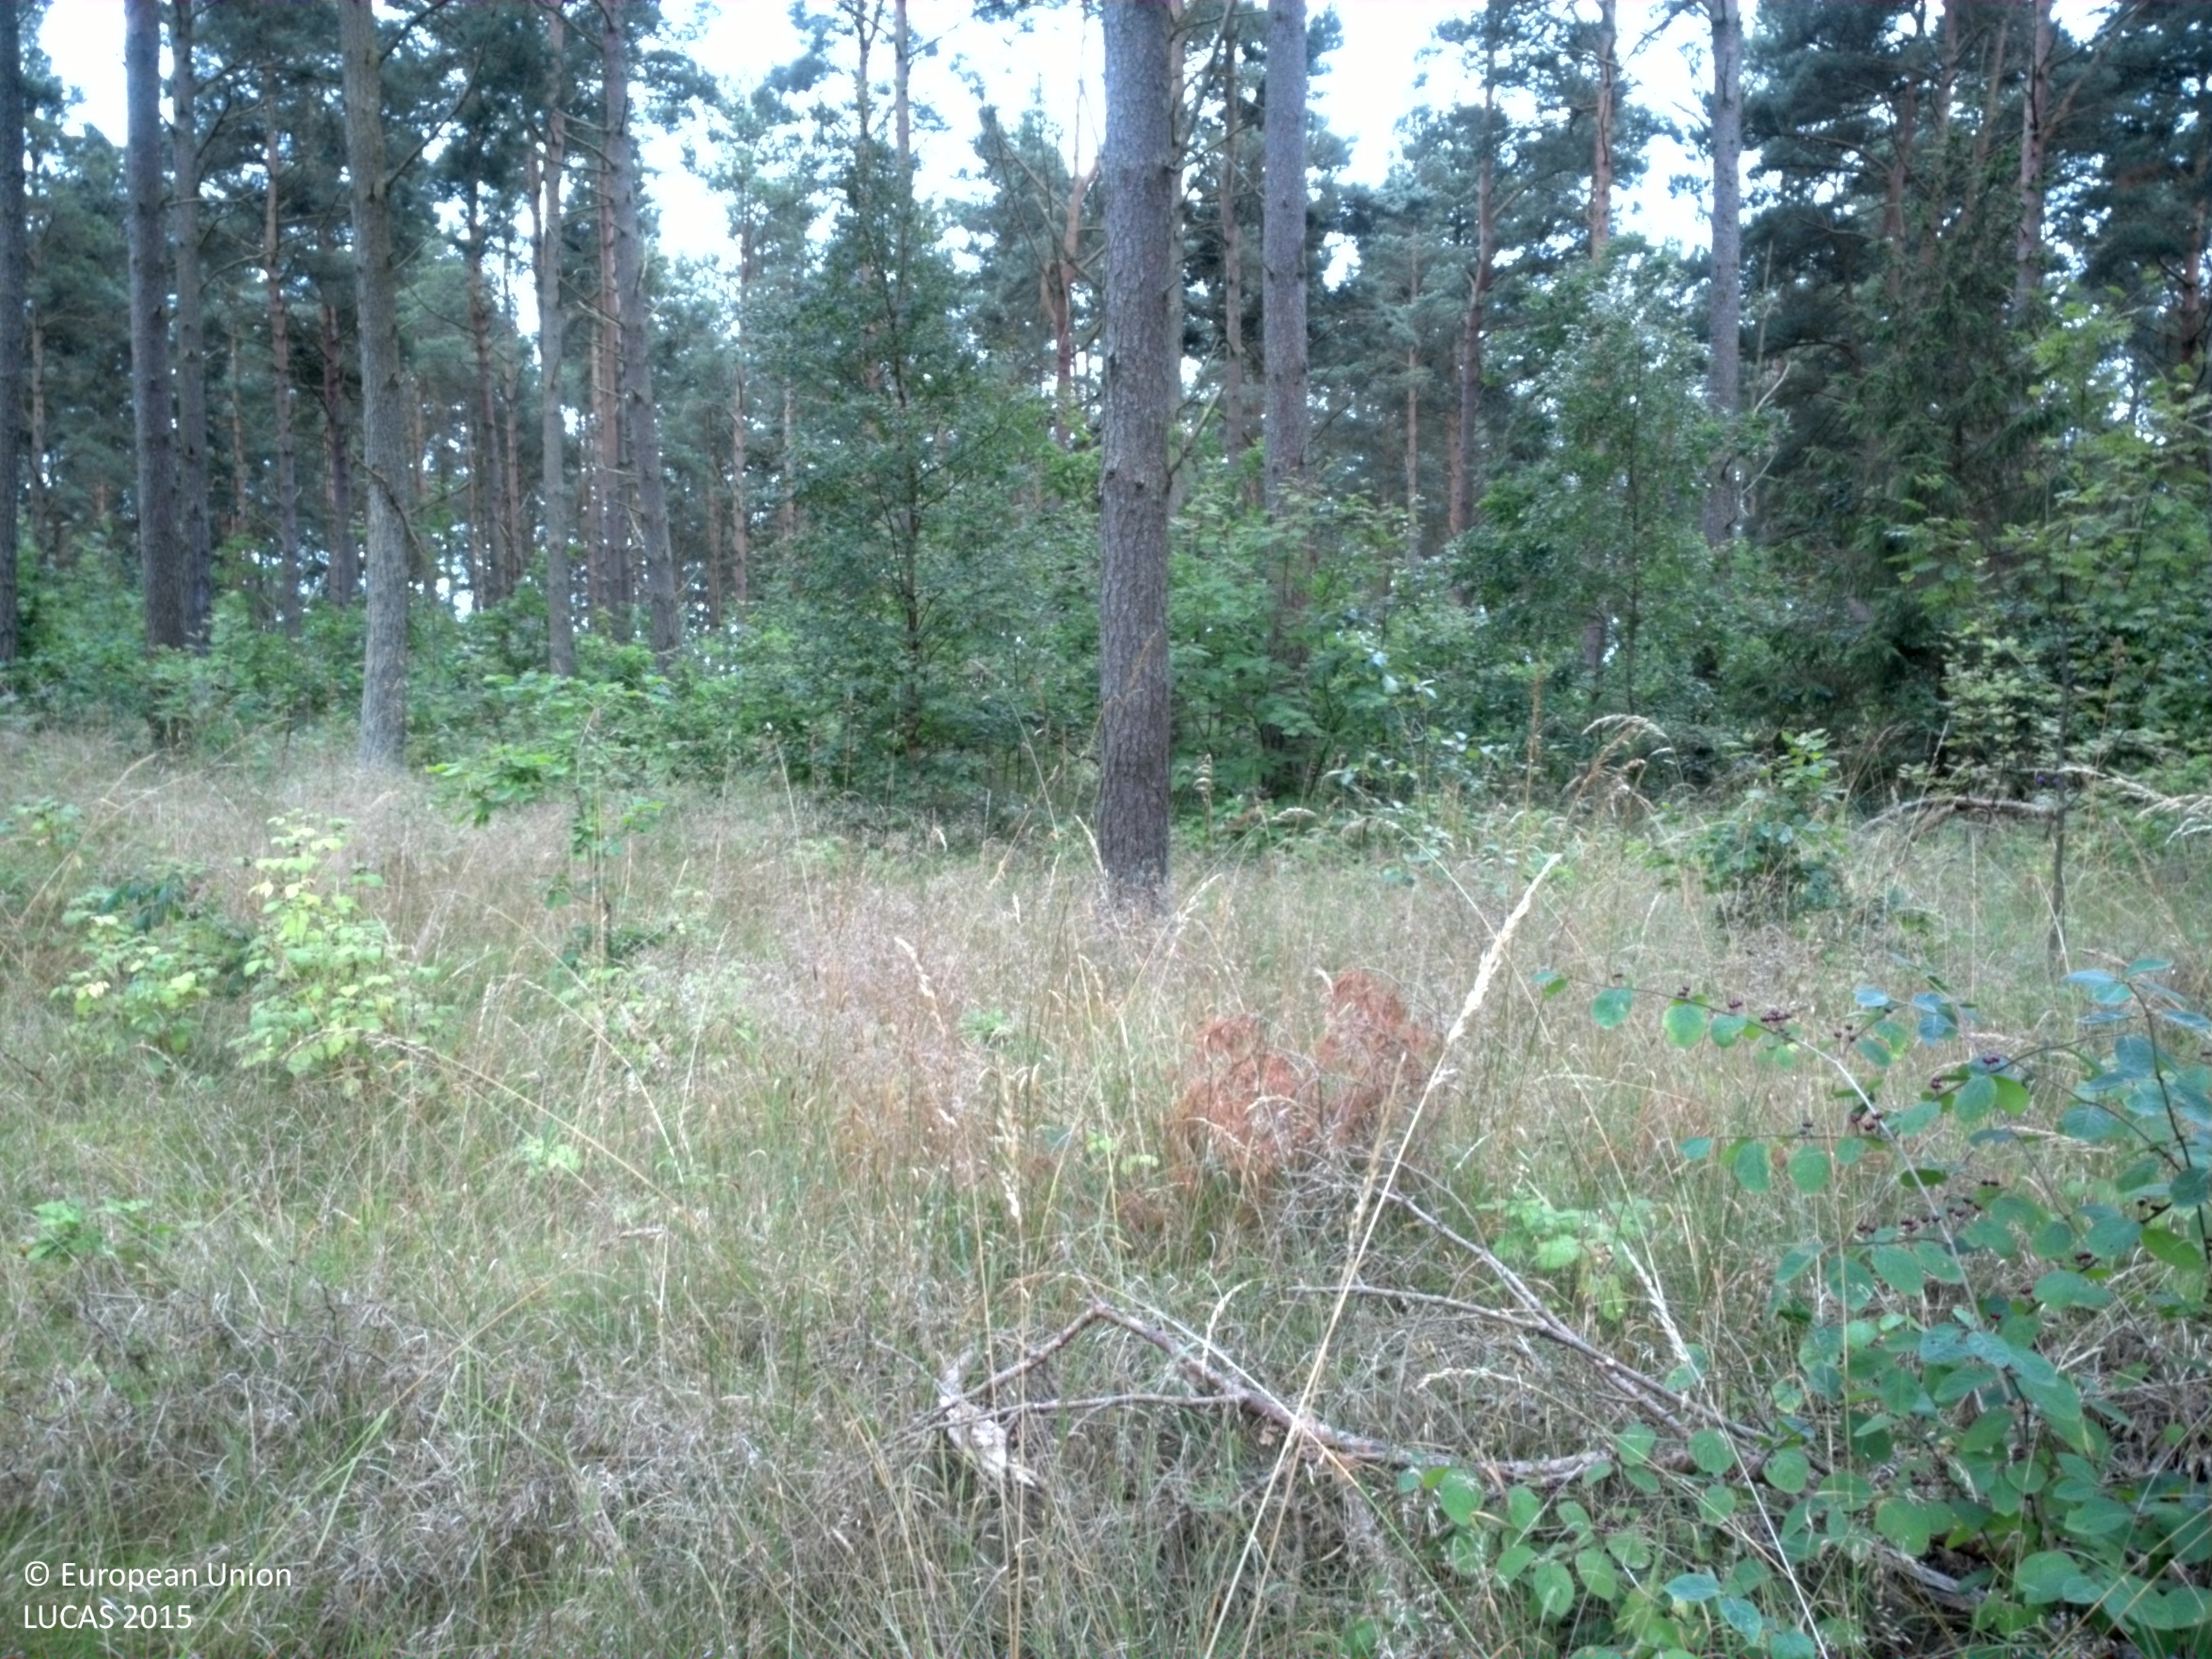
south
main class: Woodland
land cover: Pine dominated mixed woodland
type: hemiboreal forest and nemoral coniferous forest and mixed broadleaved-coniferous forest
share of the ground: > 75 %
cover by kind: coniferous forest trees 50 %, broadleaved forest trees 25 %, herbaceous plants 20 %, shrubs 5 %
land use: Forestry
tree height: > 5 m
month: July
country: SE
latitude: 57.2328
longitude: 18.6749
